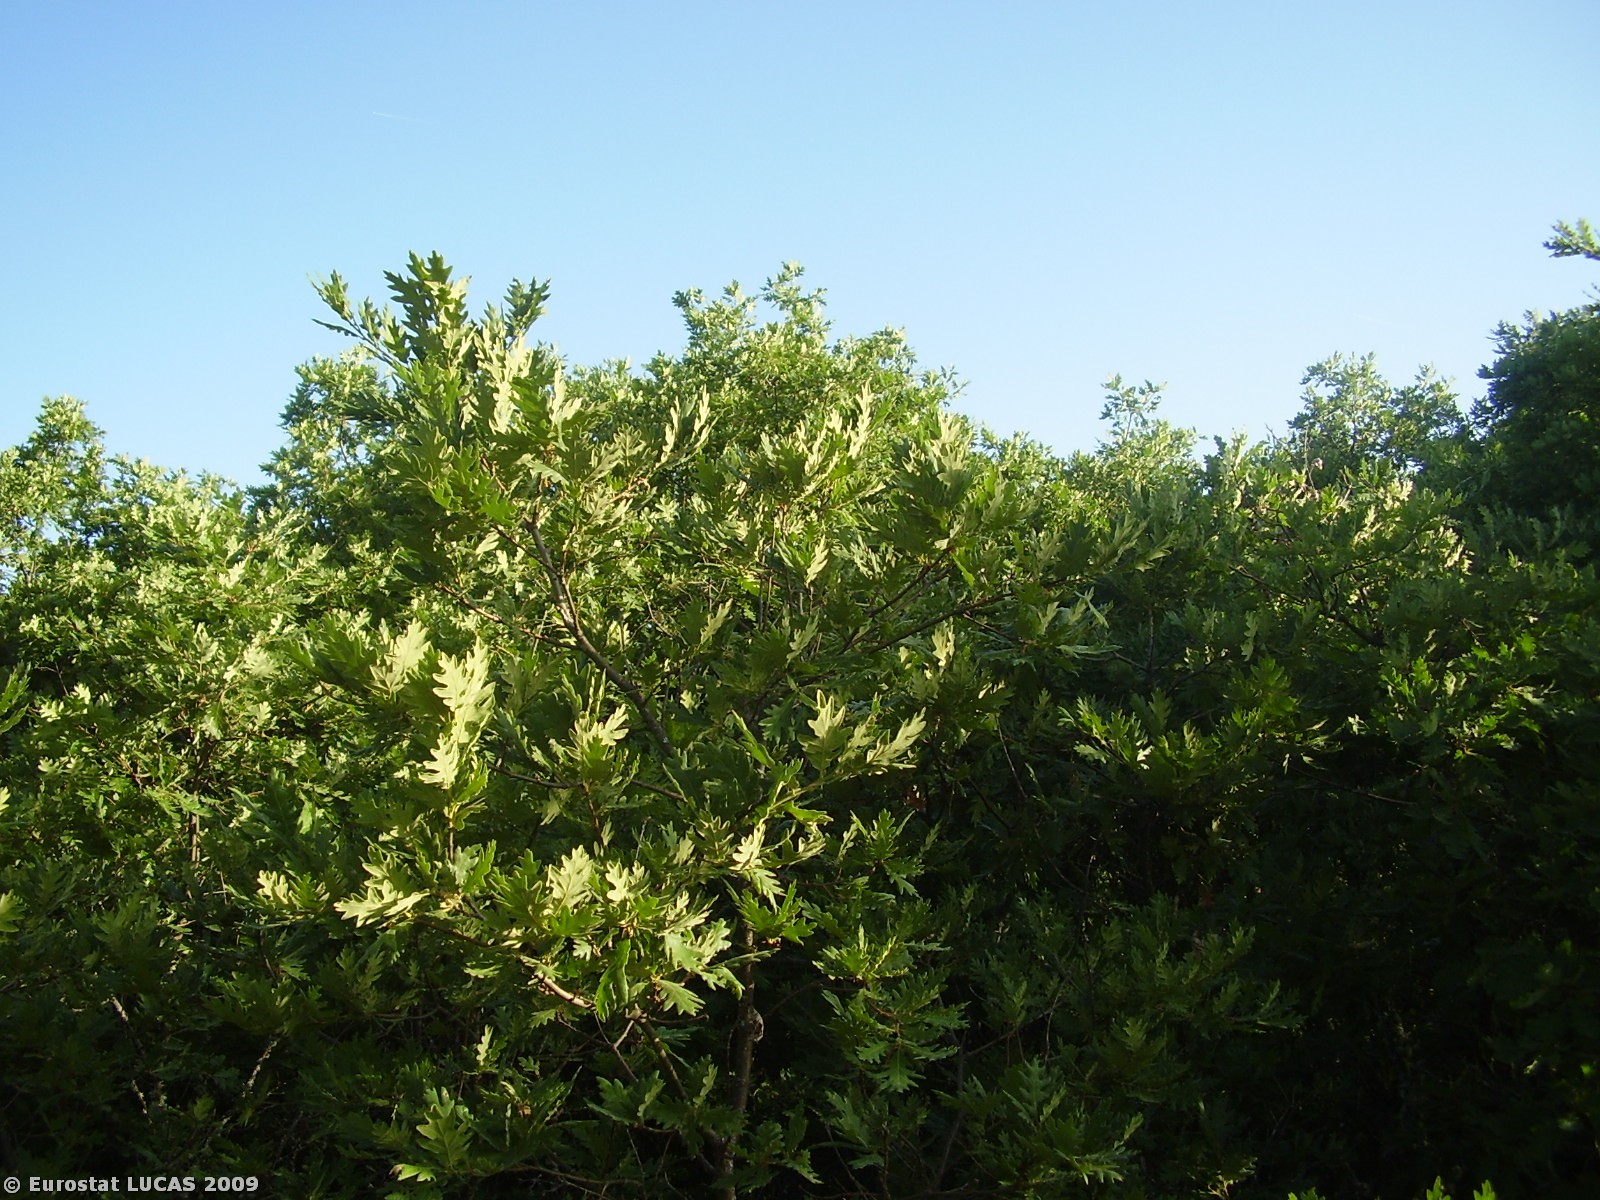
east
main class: Woodland
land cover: Broadleaved woodland
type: thermophilous deciduous forest
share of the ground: > 75 %
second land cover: Spontaneously vegetated surfaces
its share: 10 - 25 %
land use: Nature reserves
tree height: > 5 m
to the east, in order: Broadleaved woodland; Spontaneously vegetated surfaces; Broadleaved woodland; Tracks; Broadleaved woodland
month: June
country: PT
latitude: 41.8176
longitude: -6.8614
